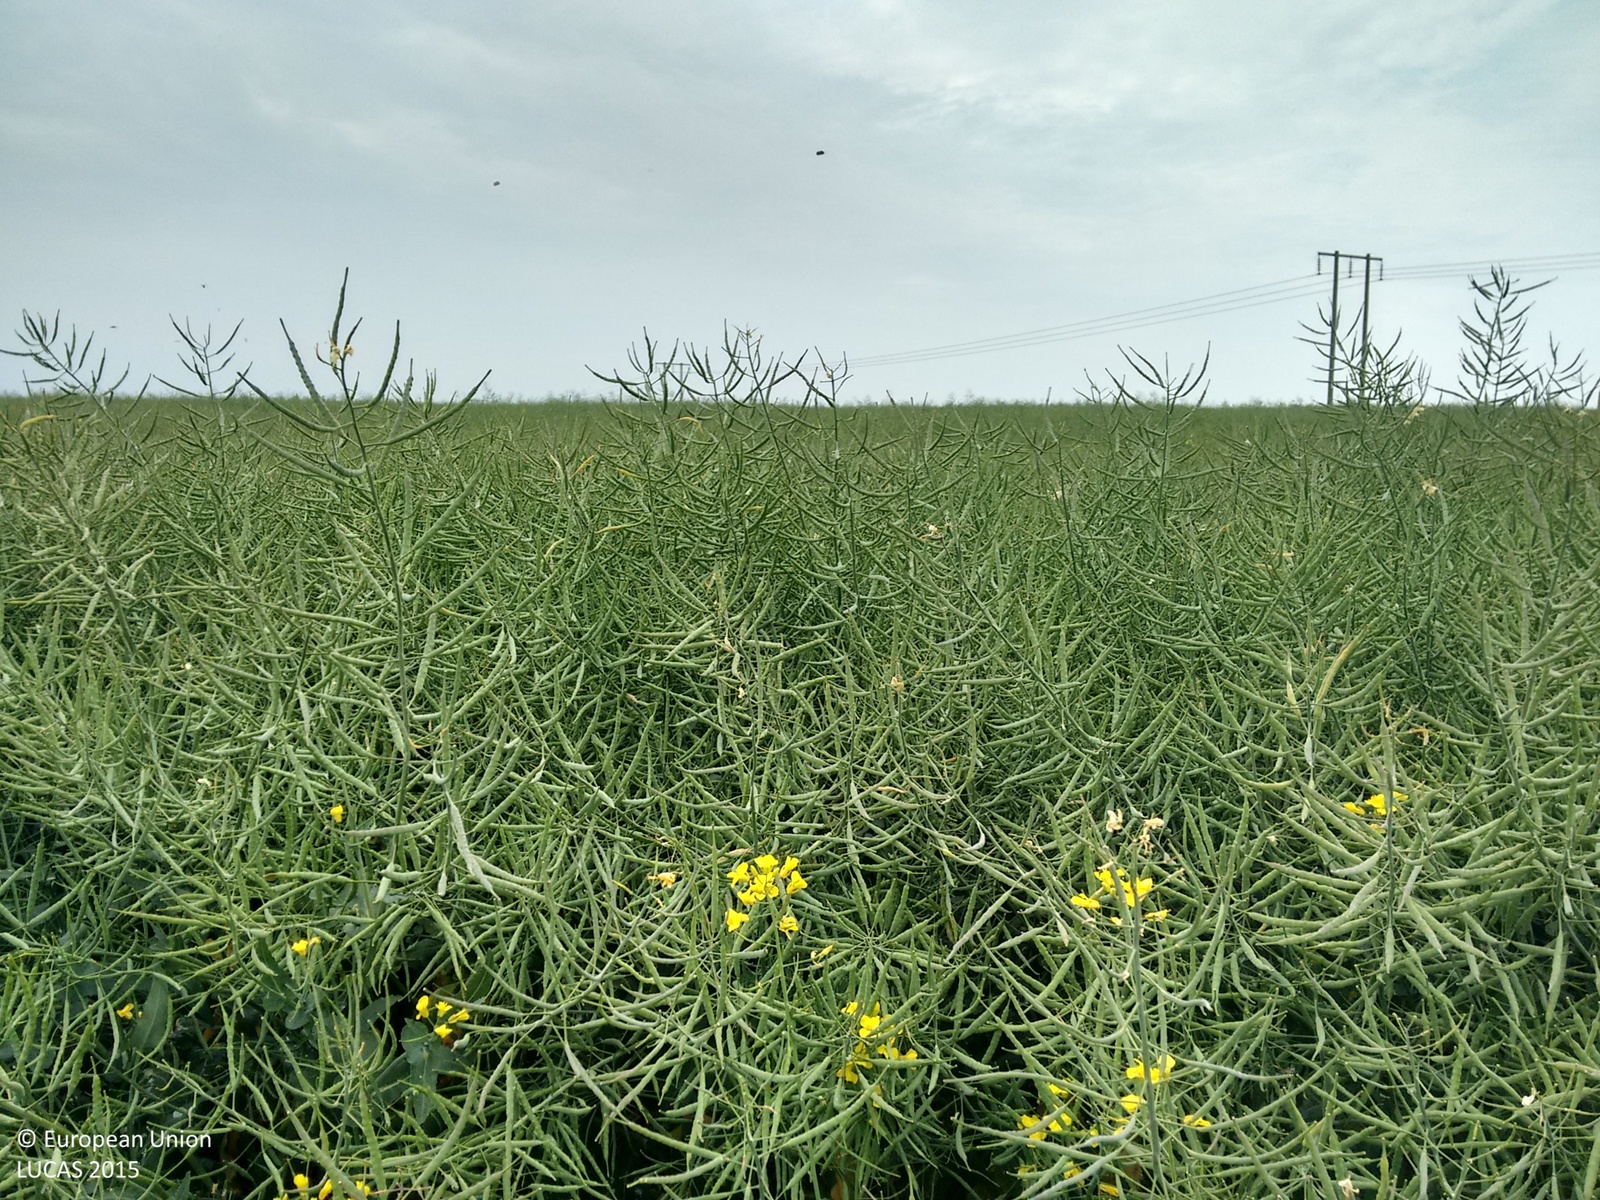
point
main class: Cropland
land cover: Rape and turnip rape
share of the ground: > 75 %
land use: Agriculture (excluding fallow land and kitchen gardens)
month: June
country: GB
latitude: 52.0916
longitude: -1.6569
